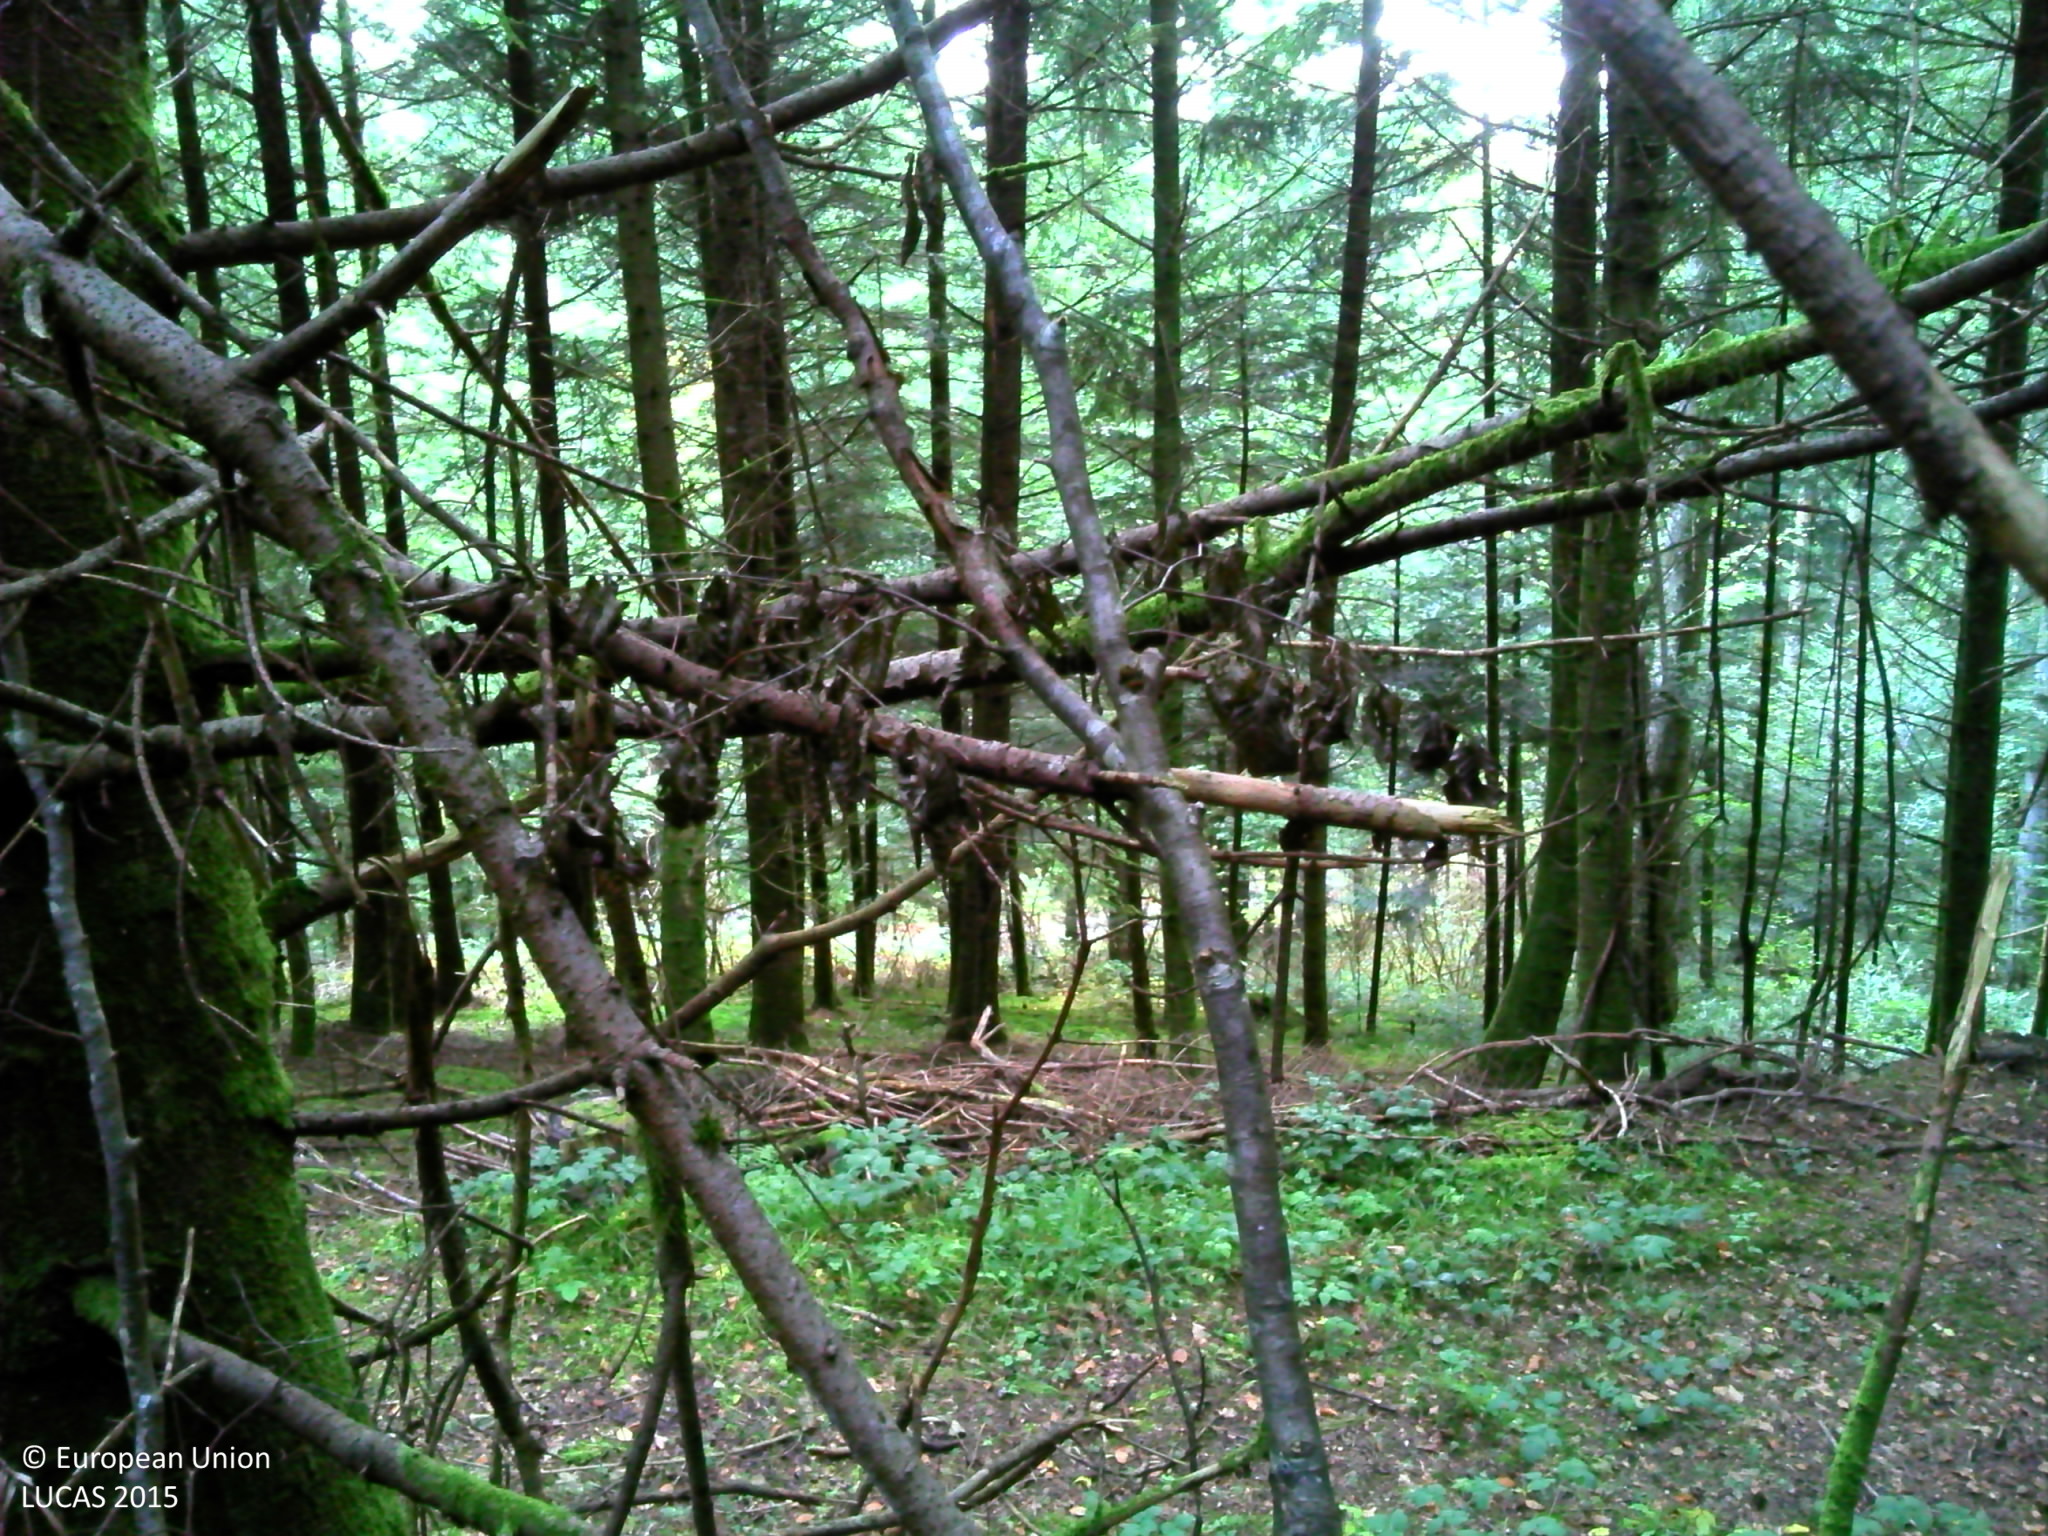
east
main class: Woodland
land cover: Other coniferous woodland
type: exotic forest
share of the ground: 50 - 75 %
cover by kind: coniferous forest trees 60 %, lichens and mosses 30 %, broadleaved forest trees 5 %, herbaceous plants 5 %
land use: Forestry
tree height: > 5 m
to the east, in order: Other coniferous woodland; Tracks; Other coniferous woodland; Ditches and canals; Grass margins; Tracks; Grass margins; Other coniferous woodland; Tracks; Other coniferous woodland; Tracks; Spruce dominated coniferous woodland; Pine dominated coniferous woodland
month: October
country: FR
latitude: 45.9090
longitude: 2.7920
